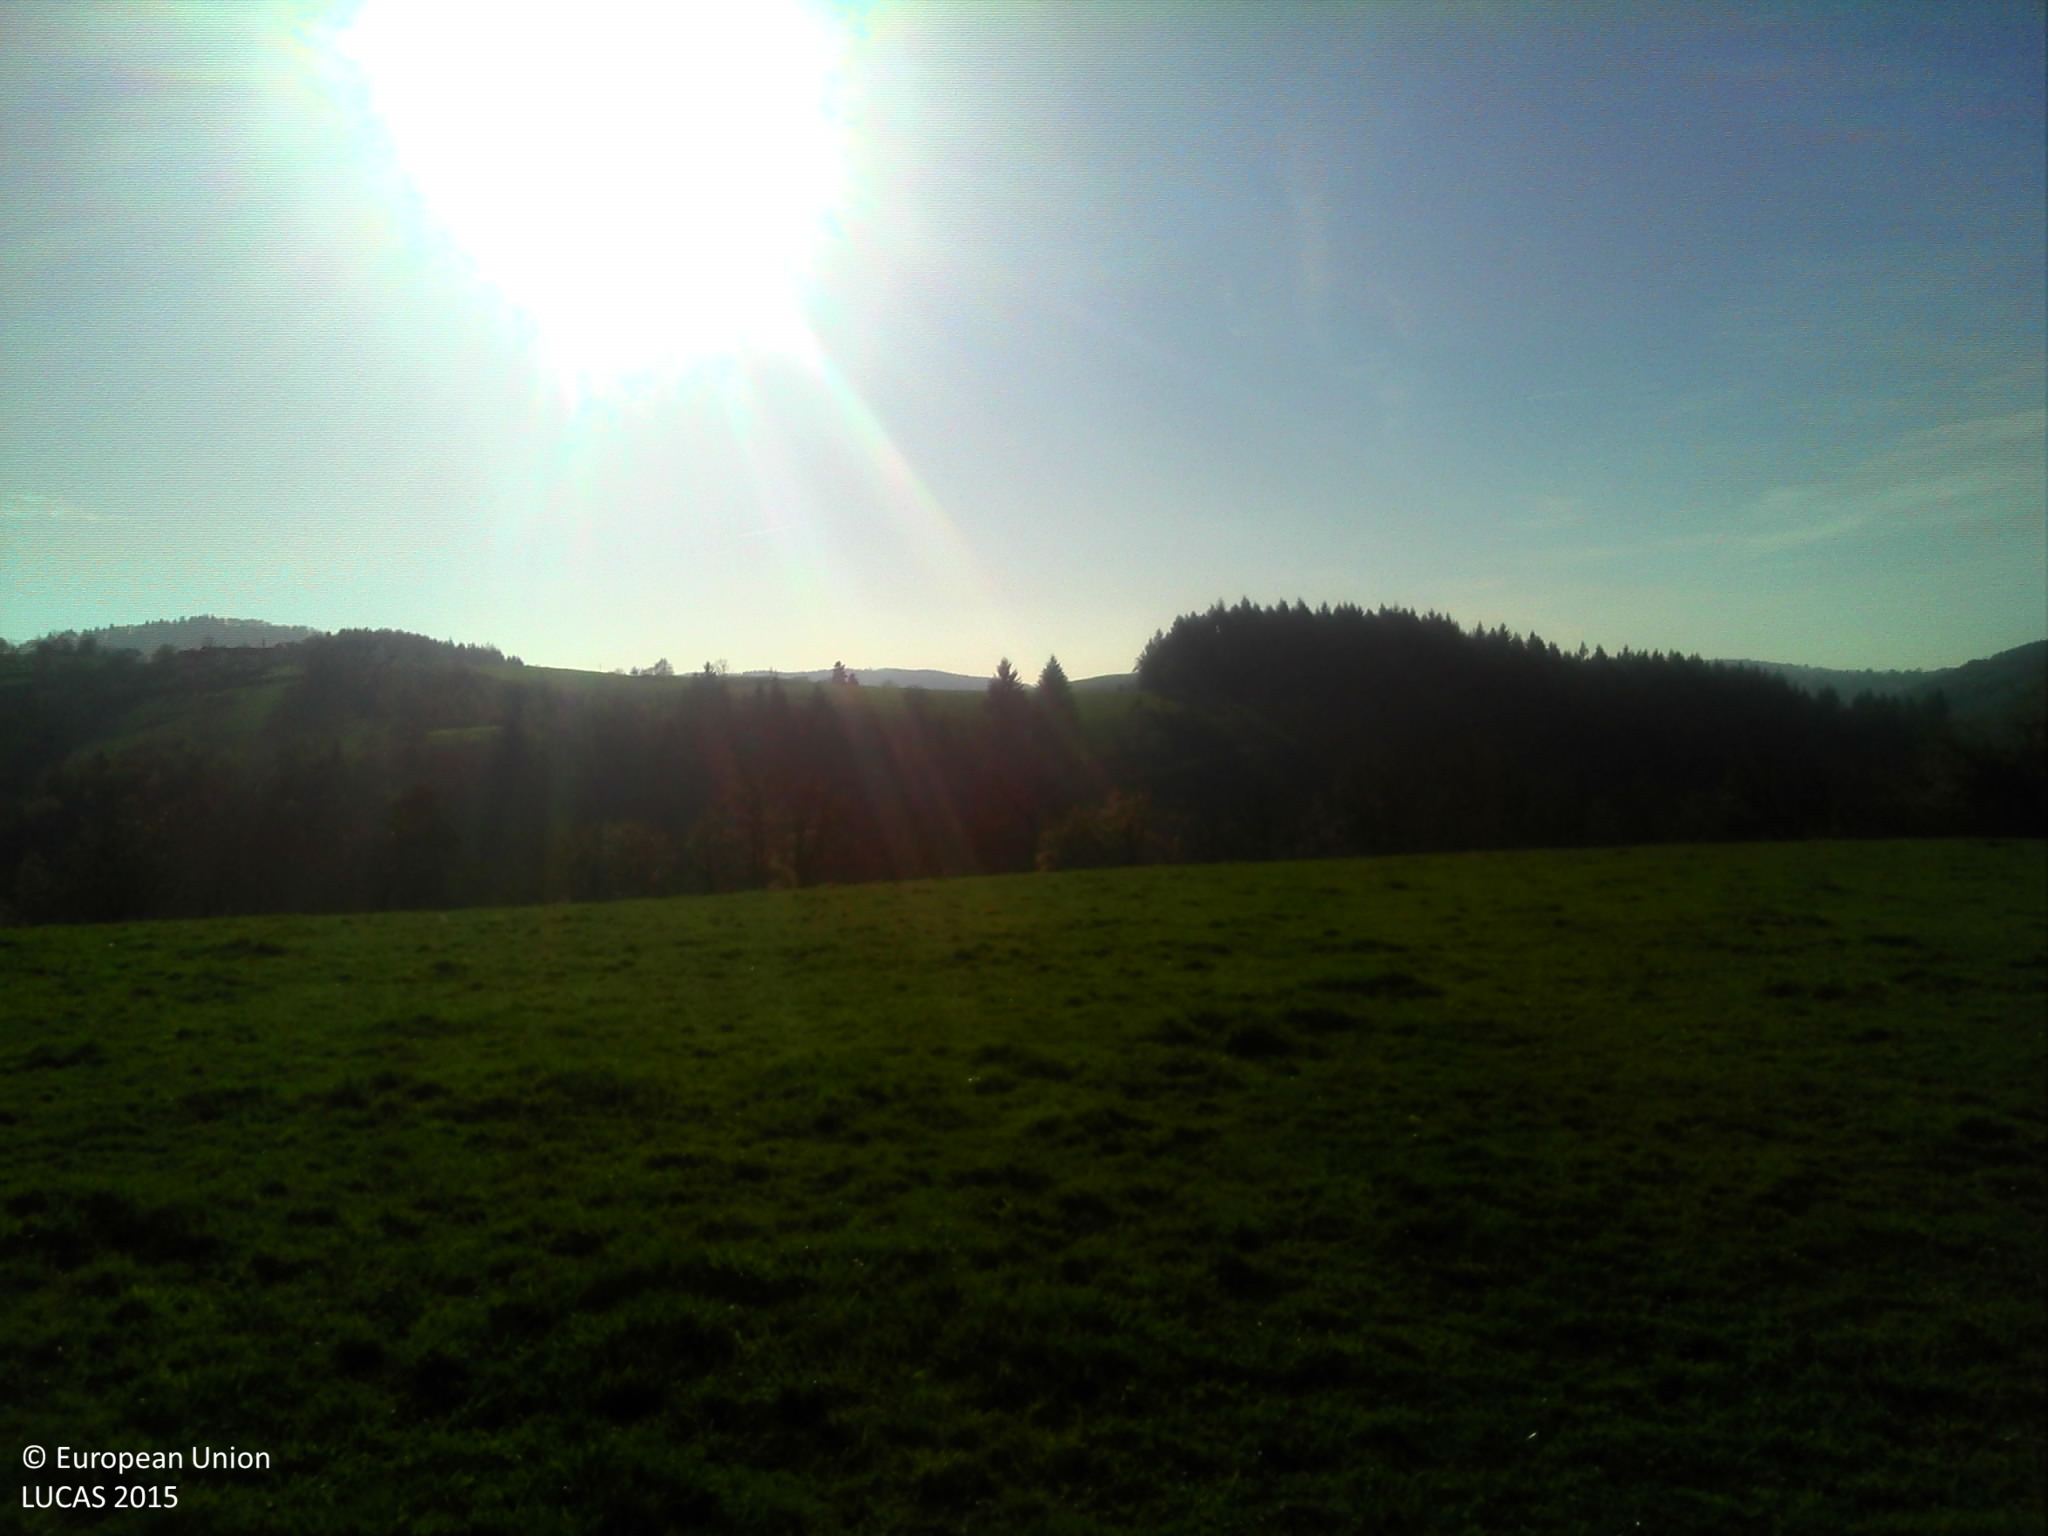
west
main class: Grassland
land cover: Grassland without tree/shrub cover
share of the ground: > 75 %
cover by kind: herbaceous plants 100 %
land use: Agriculture (excluding fallow land and kitchen gardens)
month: November
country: FR
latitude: 46.1292
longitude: 3.6974
